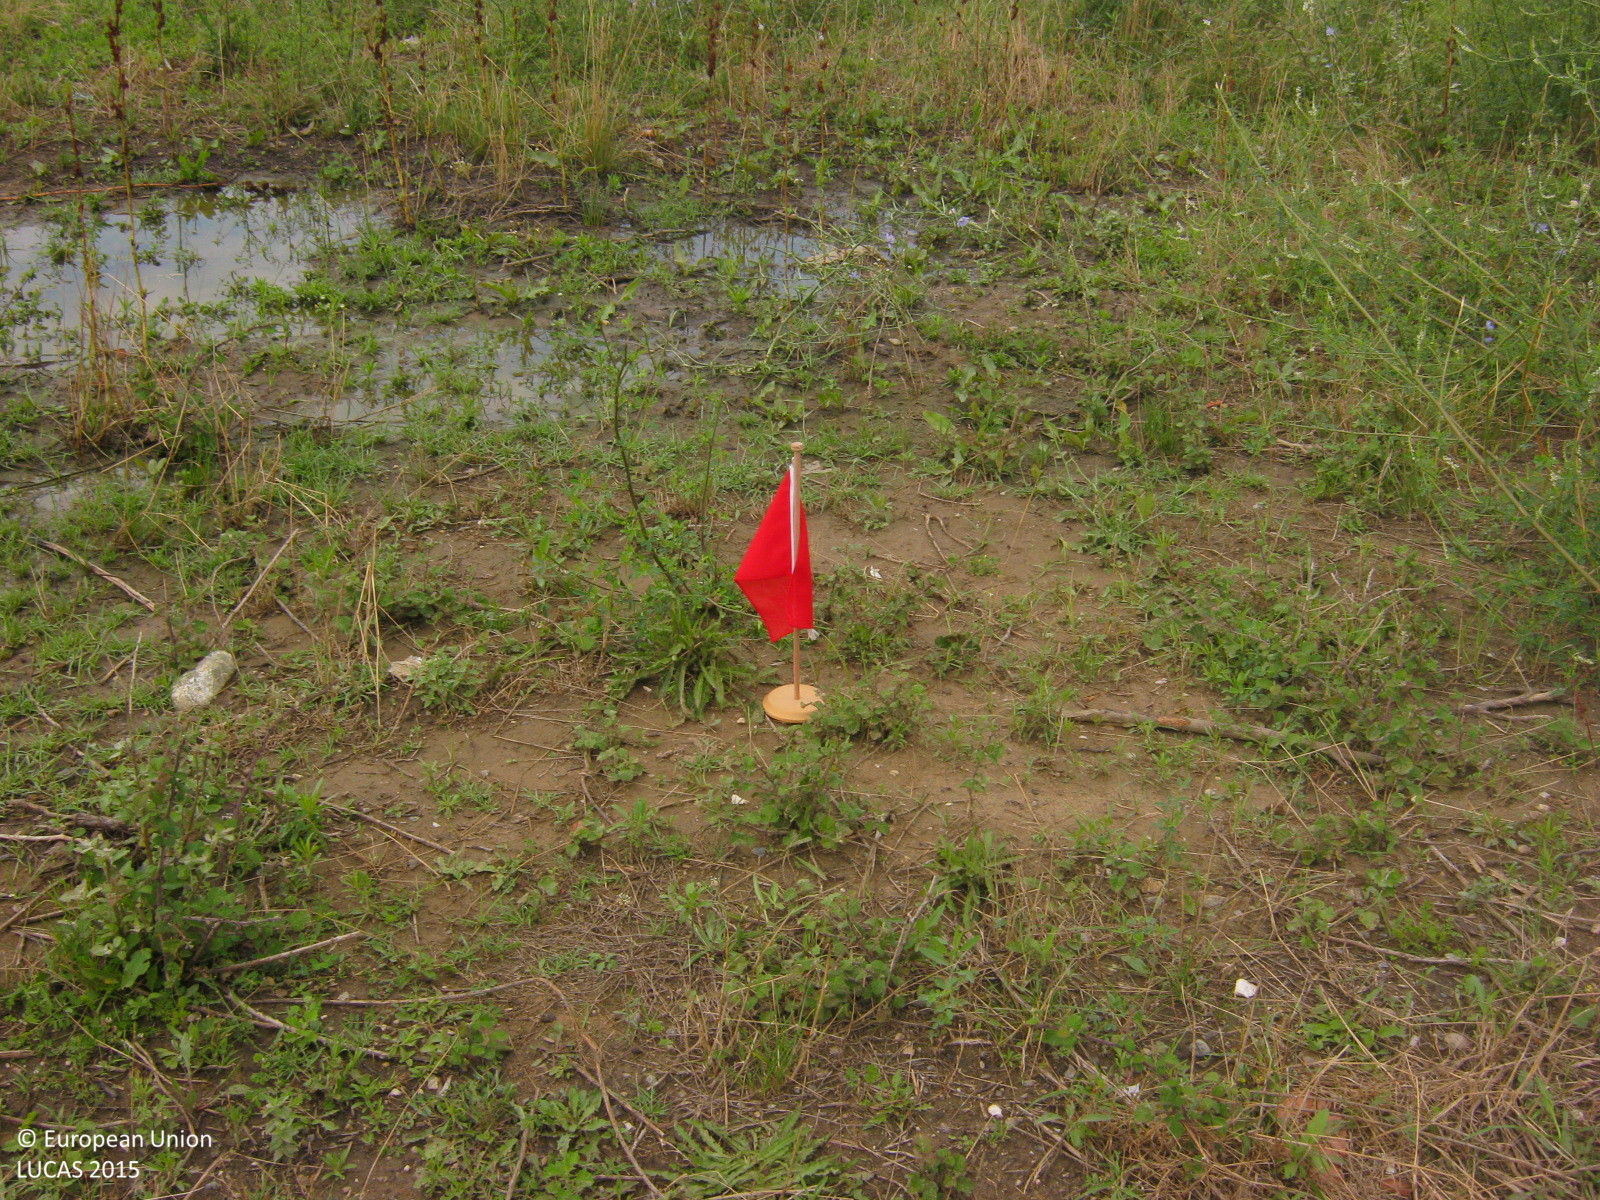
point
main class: Grassland
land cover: Spontaneously vegetated surfaces
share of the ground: > 75 %
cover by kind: herbaceous plants 100 %
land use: Abandoned areas
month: June
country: GR
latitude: 41.0743
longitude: 24.9790
